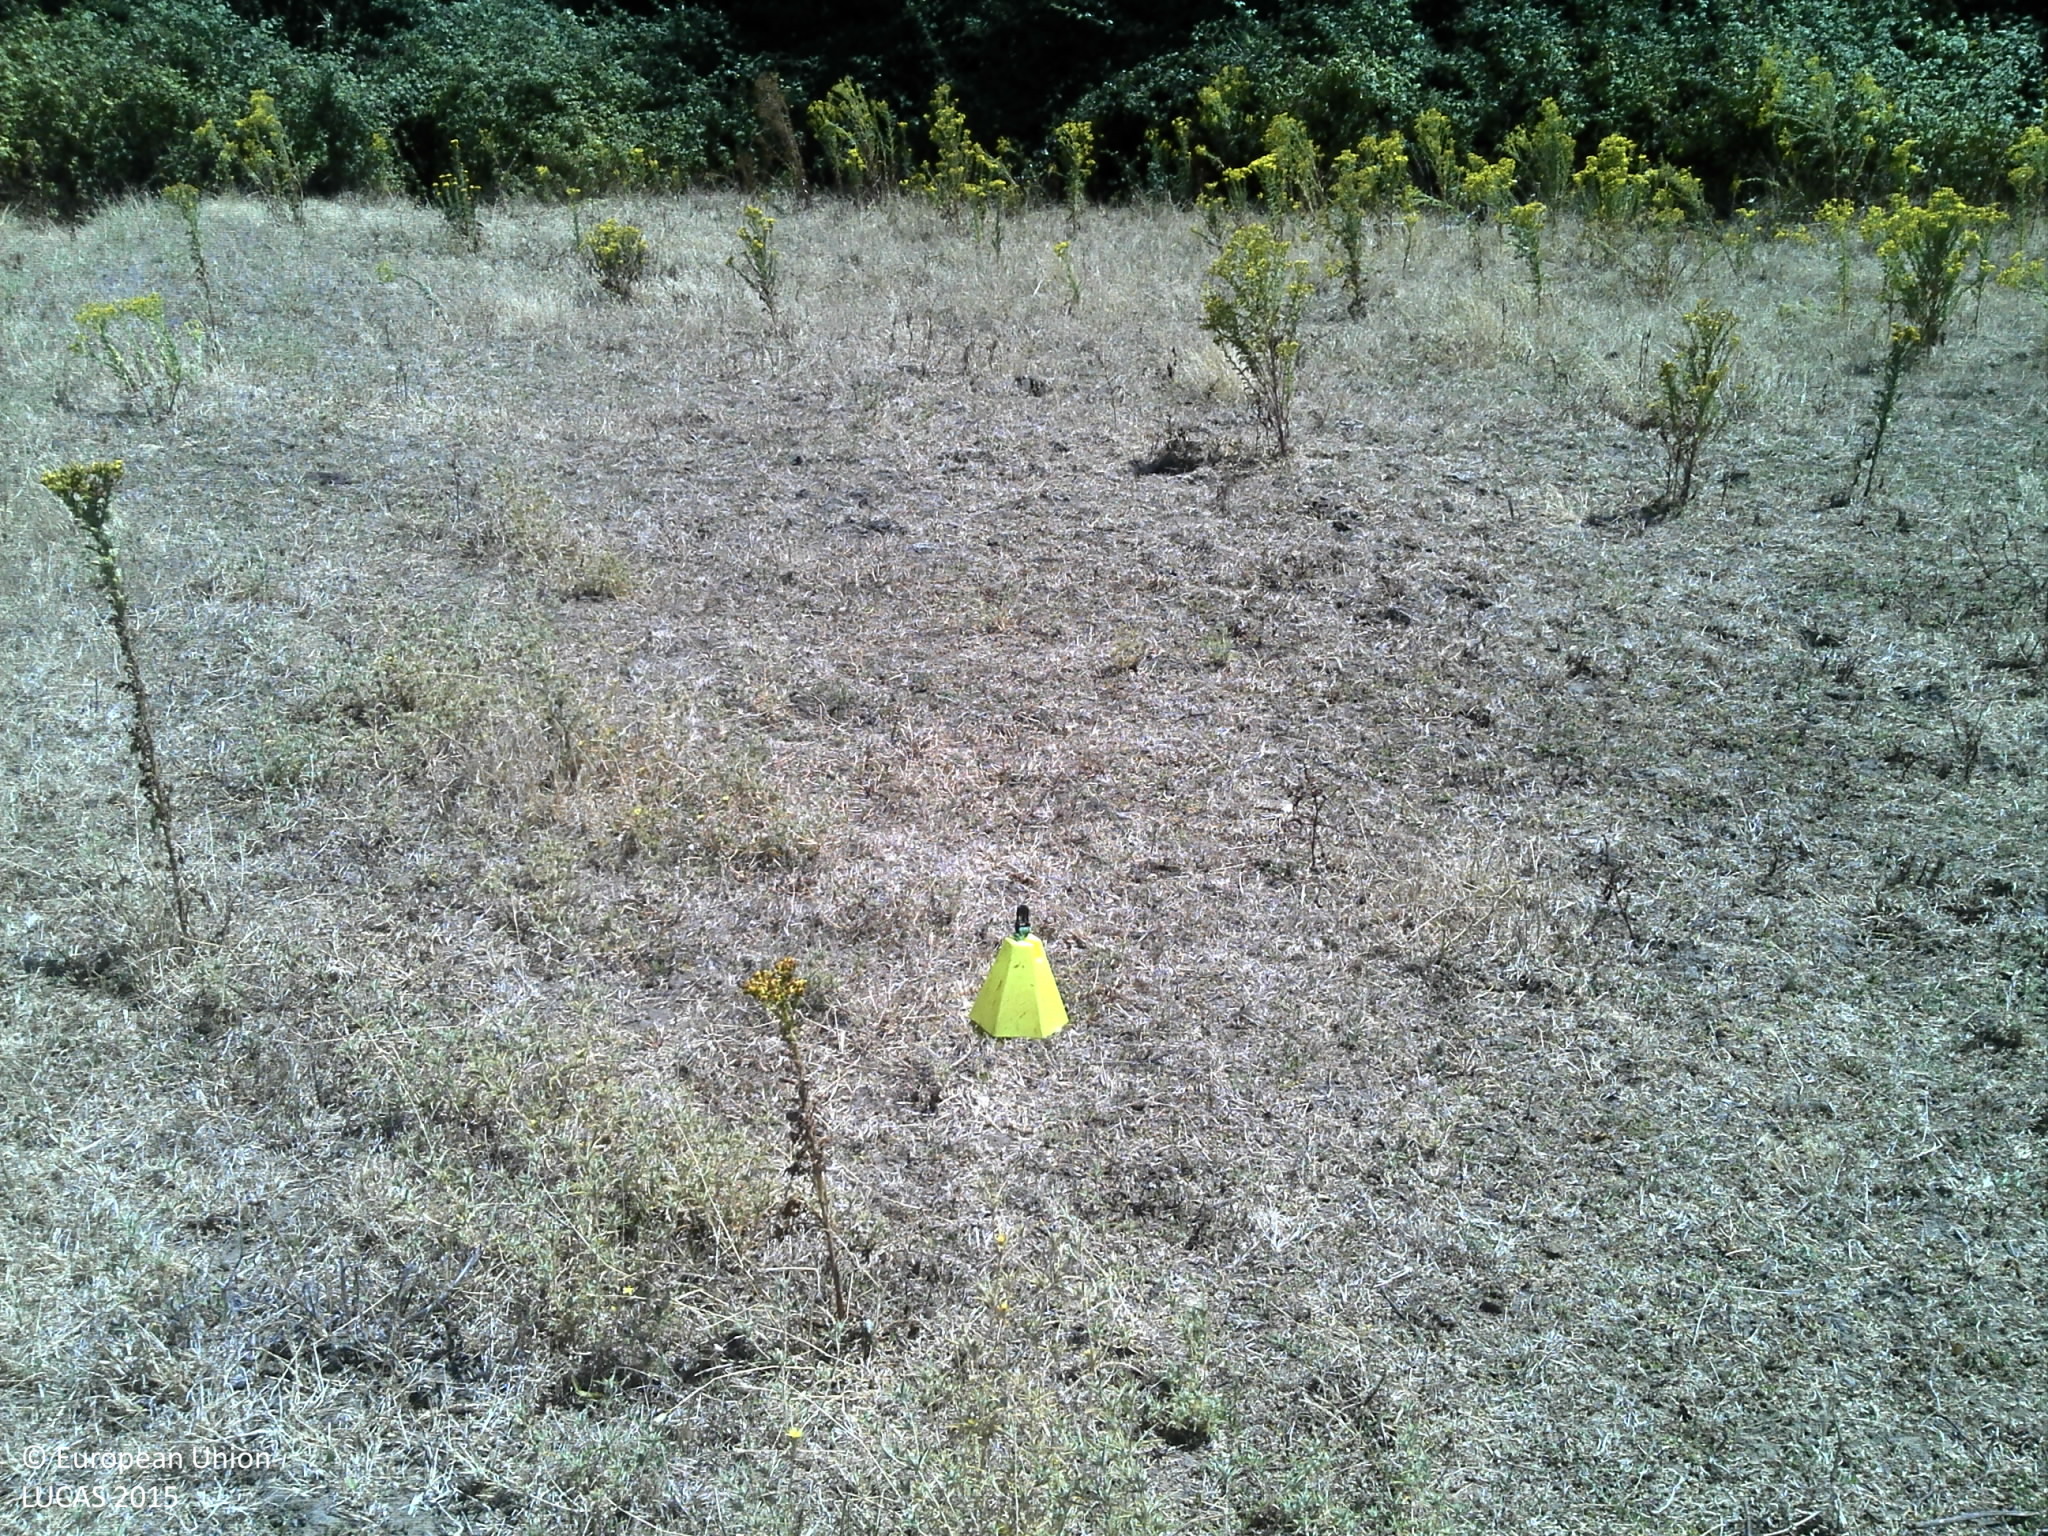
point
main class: Grassland
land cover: Grassland without tree/shrub cover
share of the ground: 25 - 50 %
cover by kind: unconsolidated bare surface 75 %, herbaceous plants 25 %
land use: Agriculture (excluding fallow land and kitchen gardens)
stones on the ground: < 10 %
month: July
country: PT
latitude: 38.9809
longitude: -7.5739
